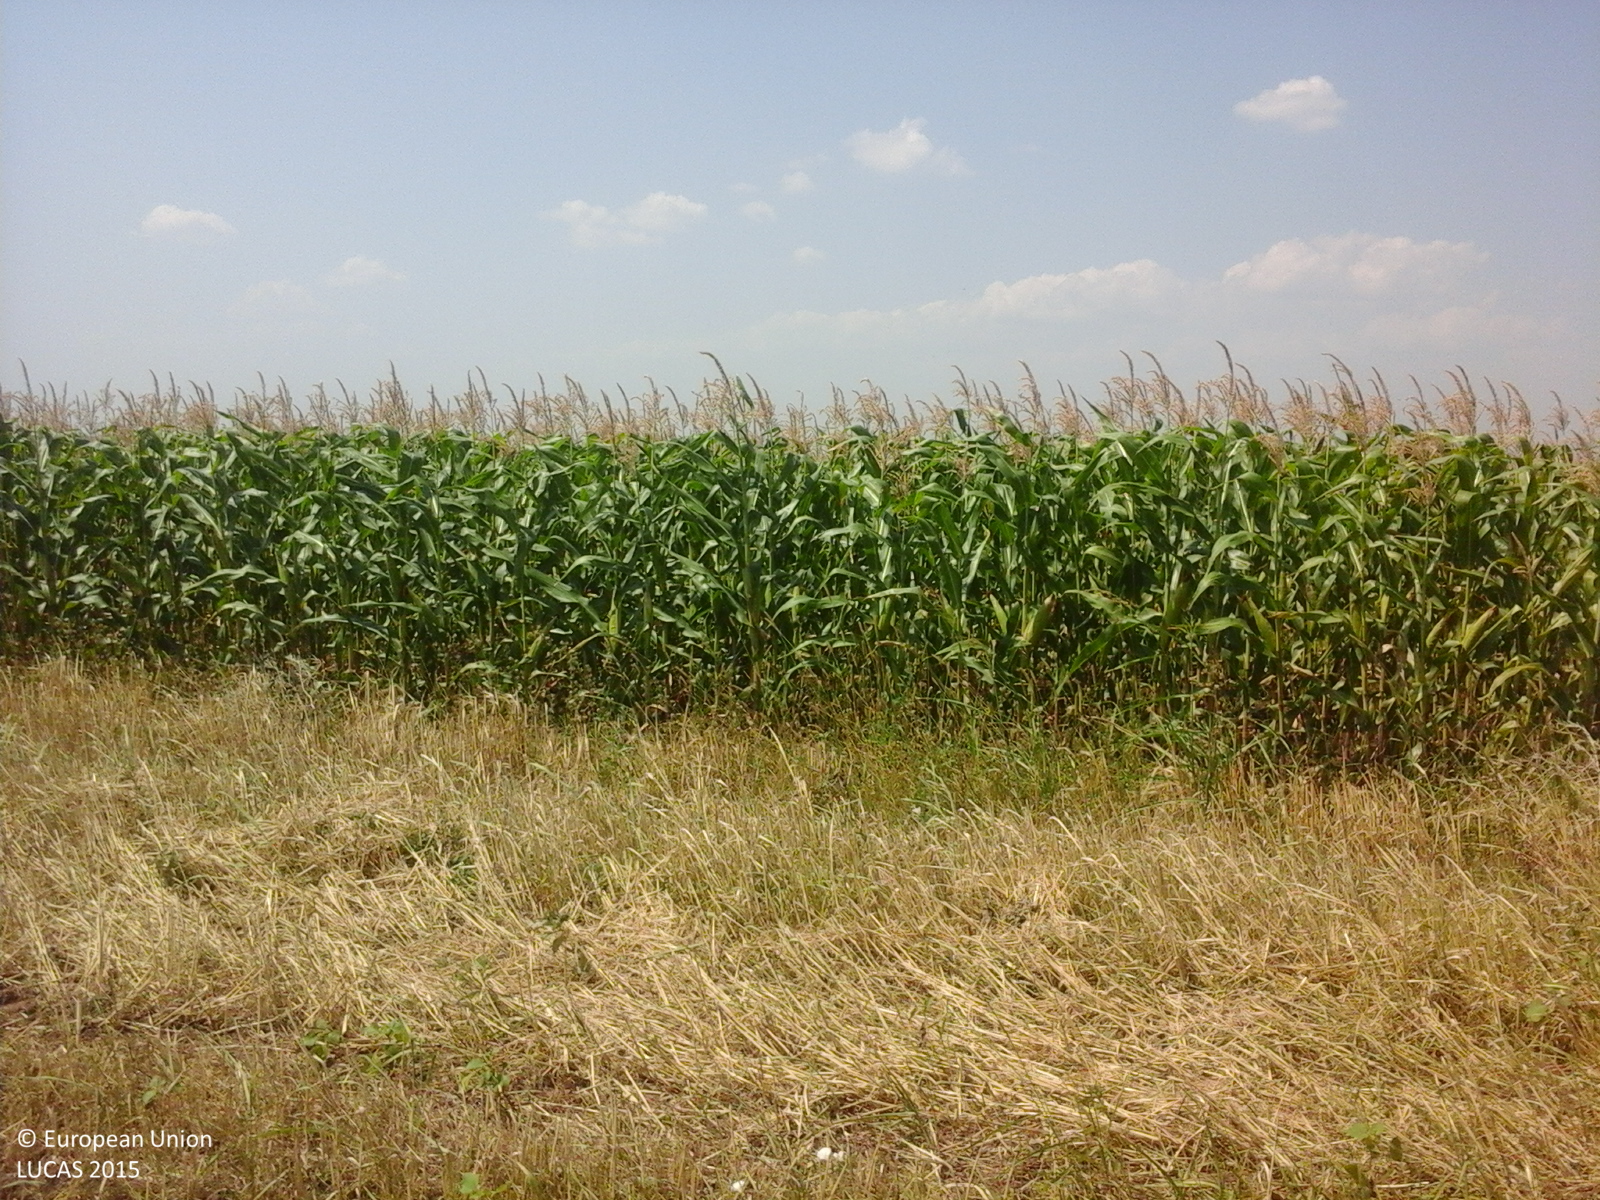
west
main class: Cropland
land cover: Maize
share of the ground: > 75 %
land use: Agriculture (excluding fallow land and kitchen gardens)
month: August
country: RO
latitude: 44.9756
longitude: 26.6731
